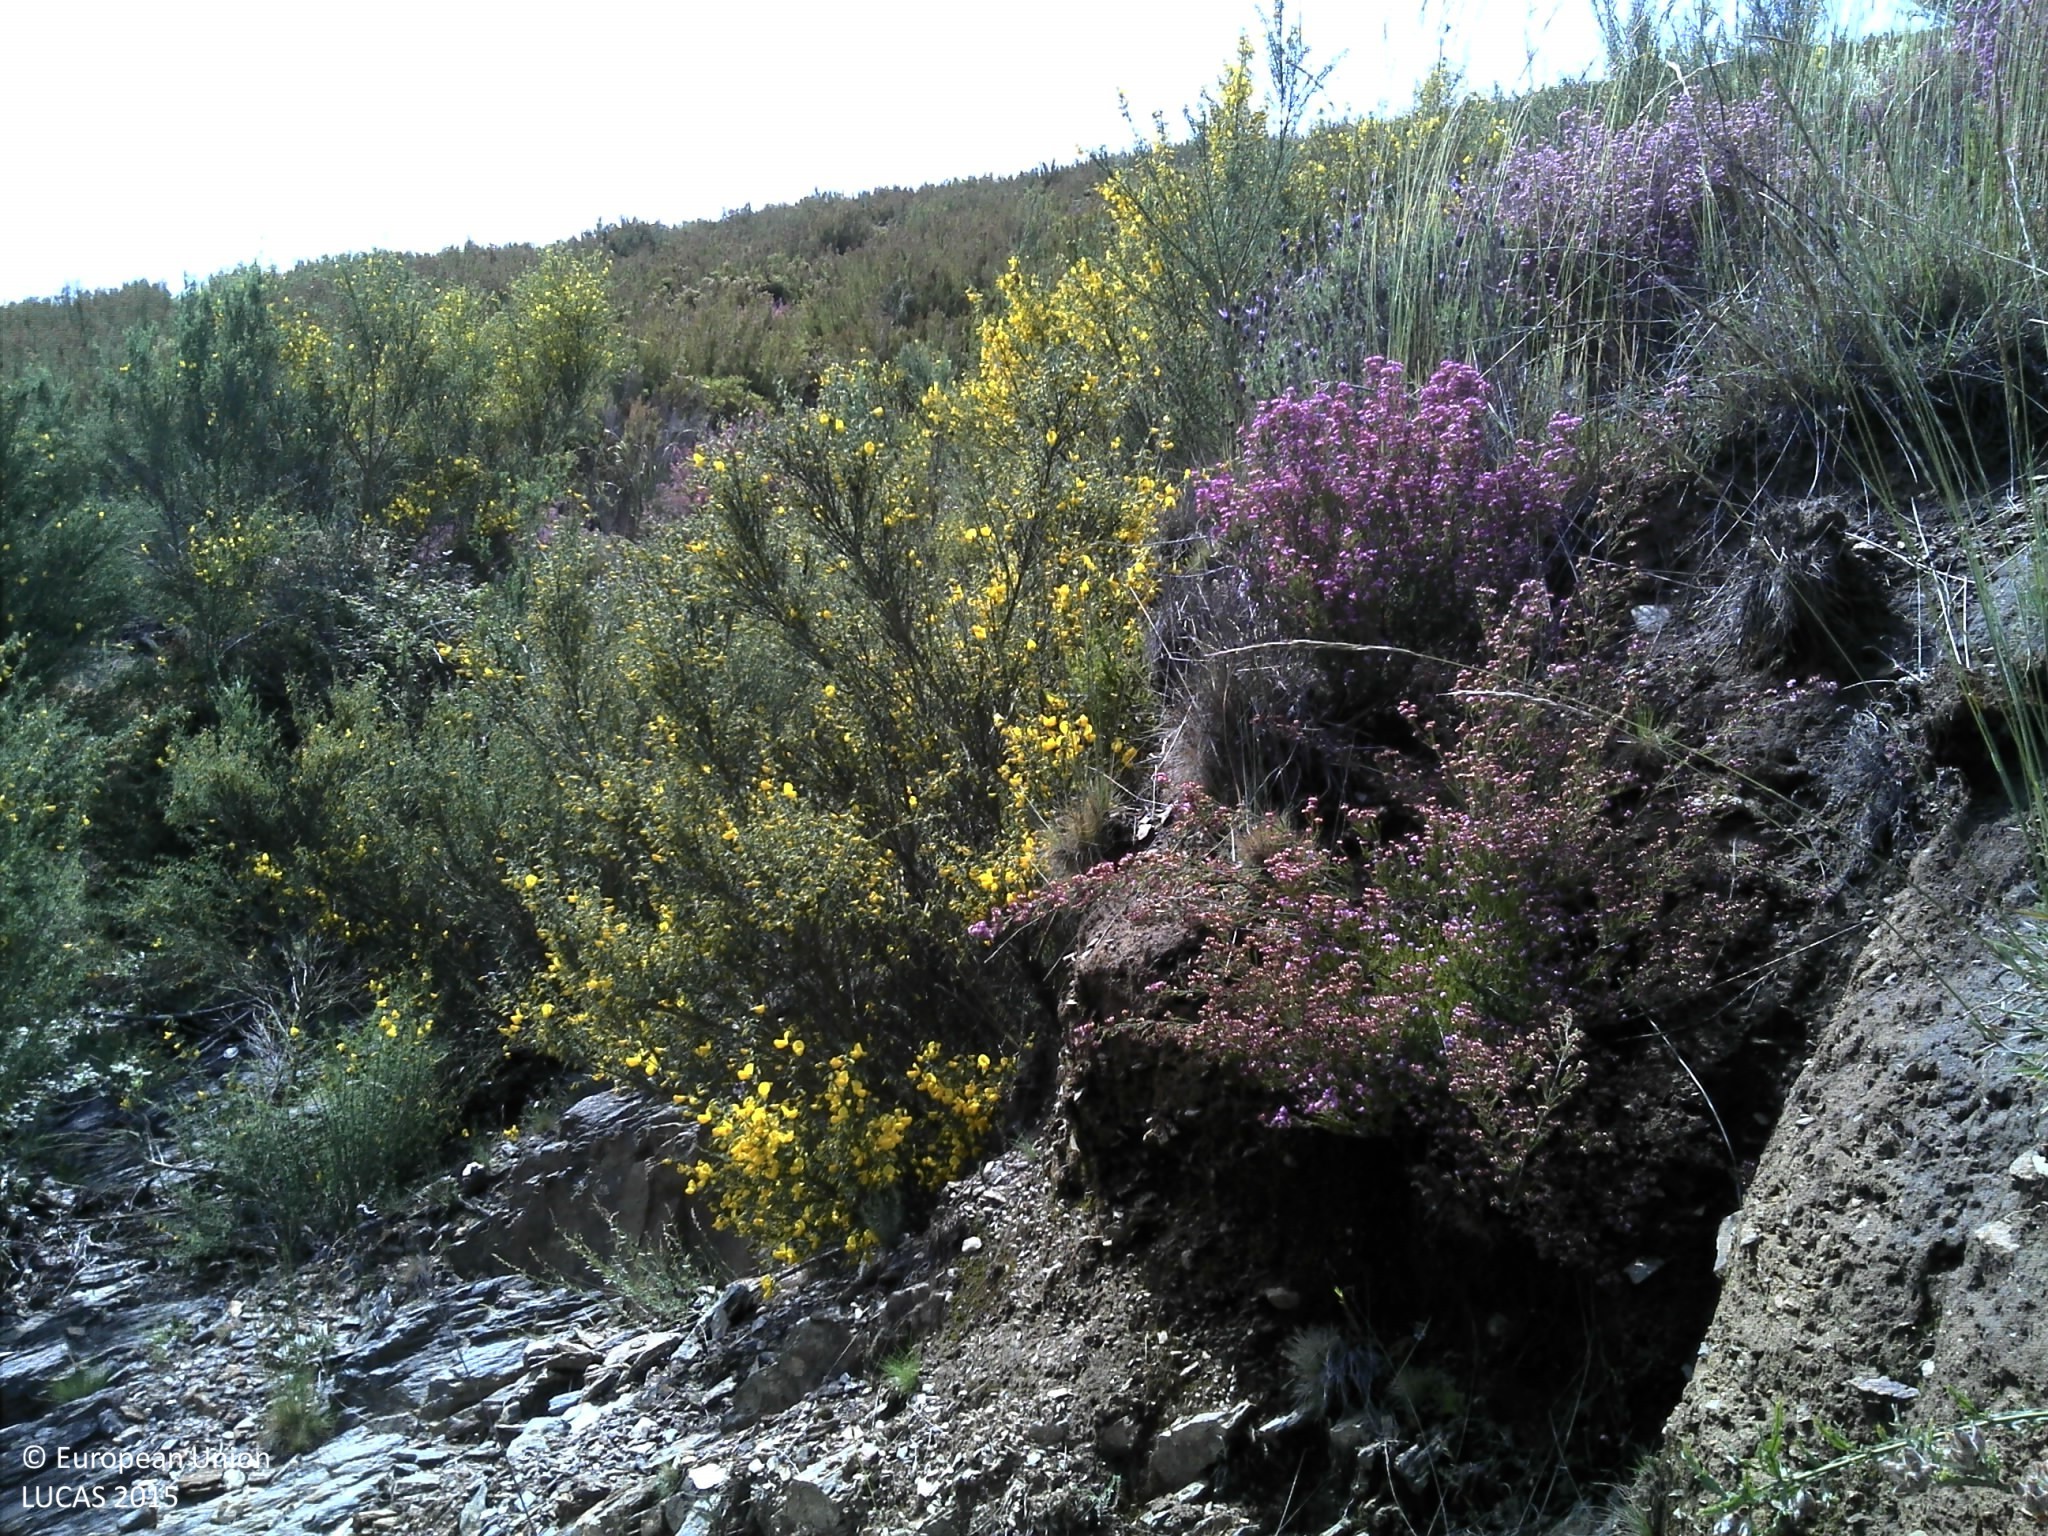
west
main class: Shrubland
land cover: Shrubland without tree cover
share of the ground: 25 - 50 %
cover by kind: shrubs 50 %, unconsolidated bare surface 40 %, herbaceous plants 10 %
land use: Semi-natural and natural areas not in use
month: May
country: PT
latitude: 41.9257
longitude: -7.0898
